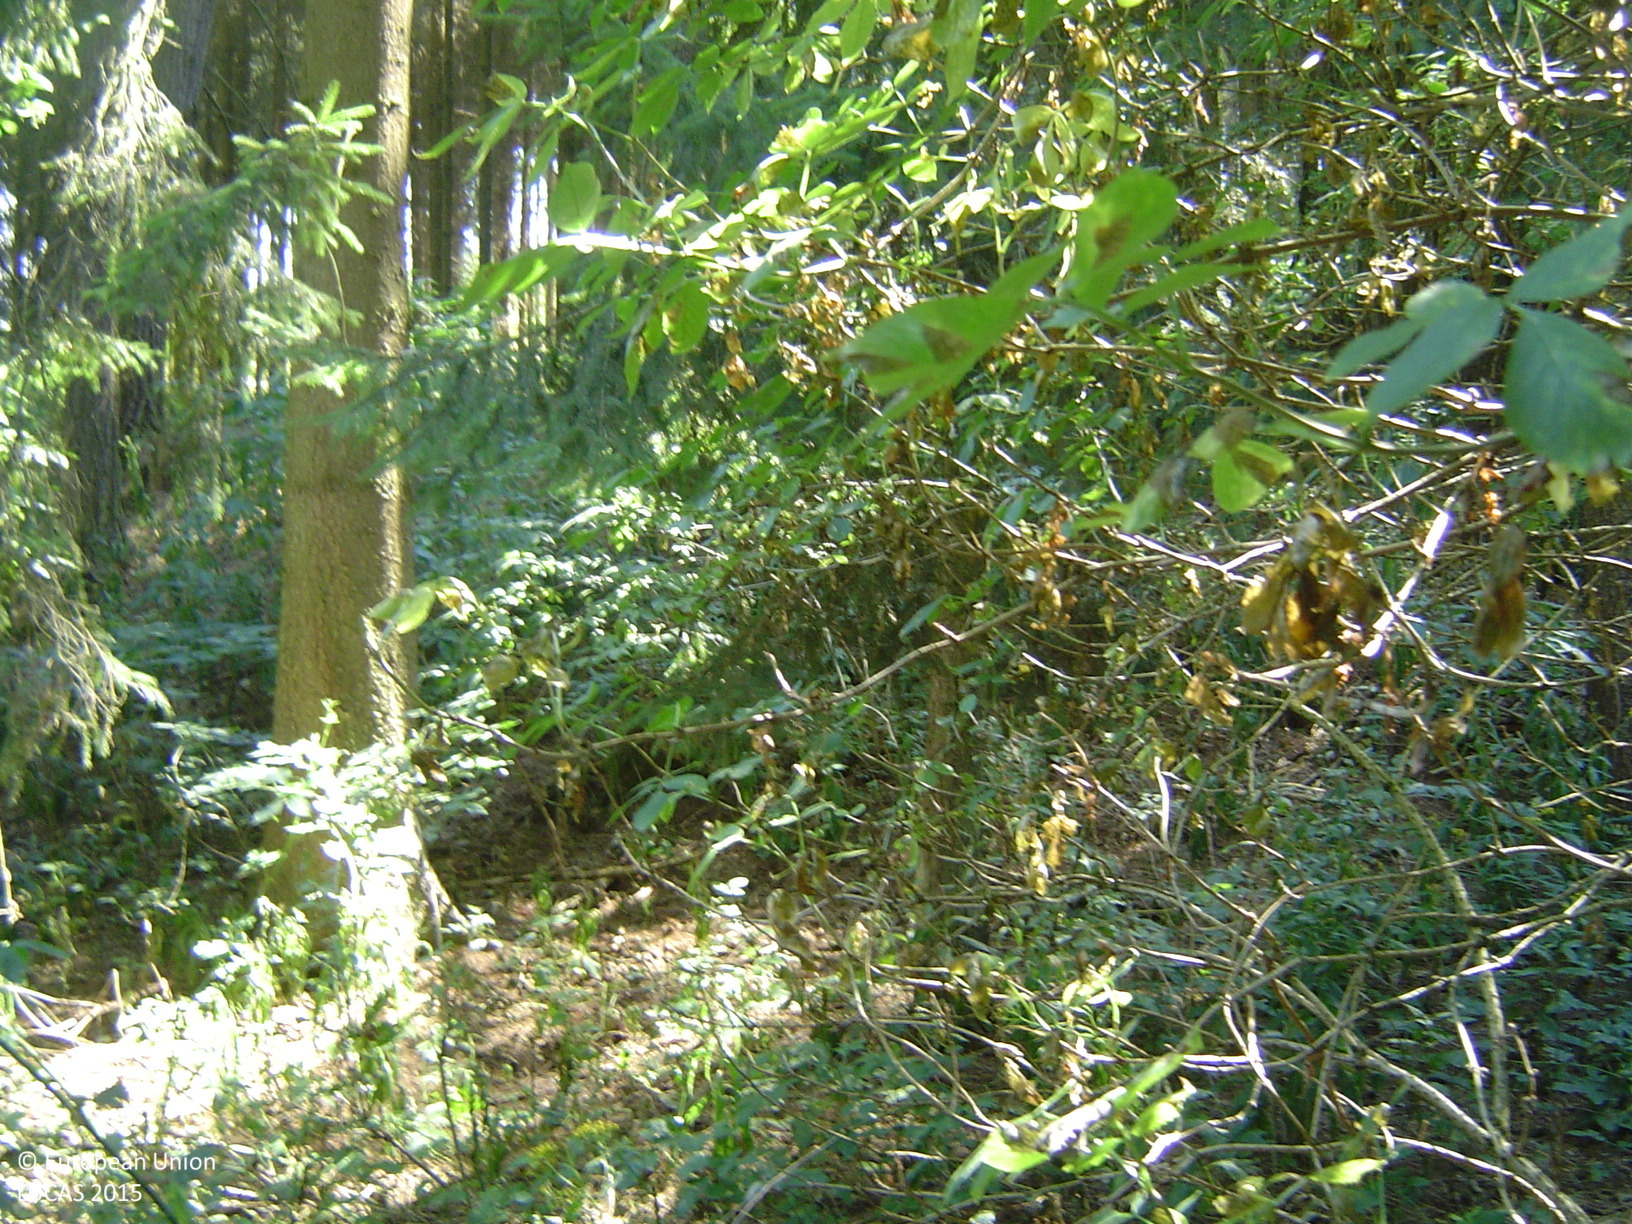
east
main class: Woodland
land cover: Broadleaved woodland
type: mesophytic deciduous forest
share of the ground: > 75 %
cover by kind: broadleaved forest trees 80 %, coniferous forest trees 10 %, shrubs 10 %
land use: Forestry
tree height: > 5 m
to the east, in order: Broadleaved woodland; Spruce dominated coniferous woodland; Broadleaved woodland; Spruce dominated coniferous woodland; Common wheat
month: August
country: CZ
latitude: 49.6315
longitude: 14.3903
